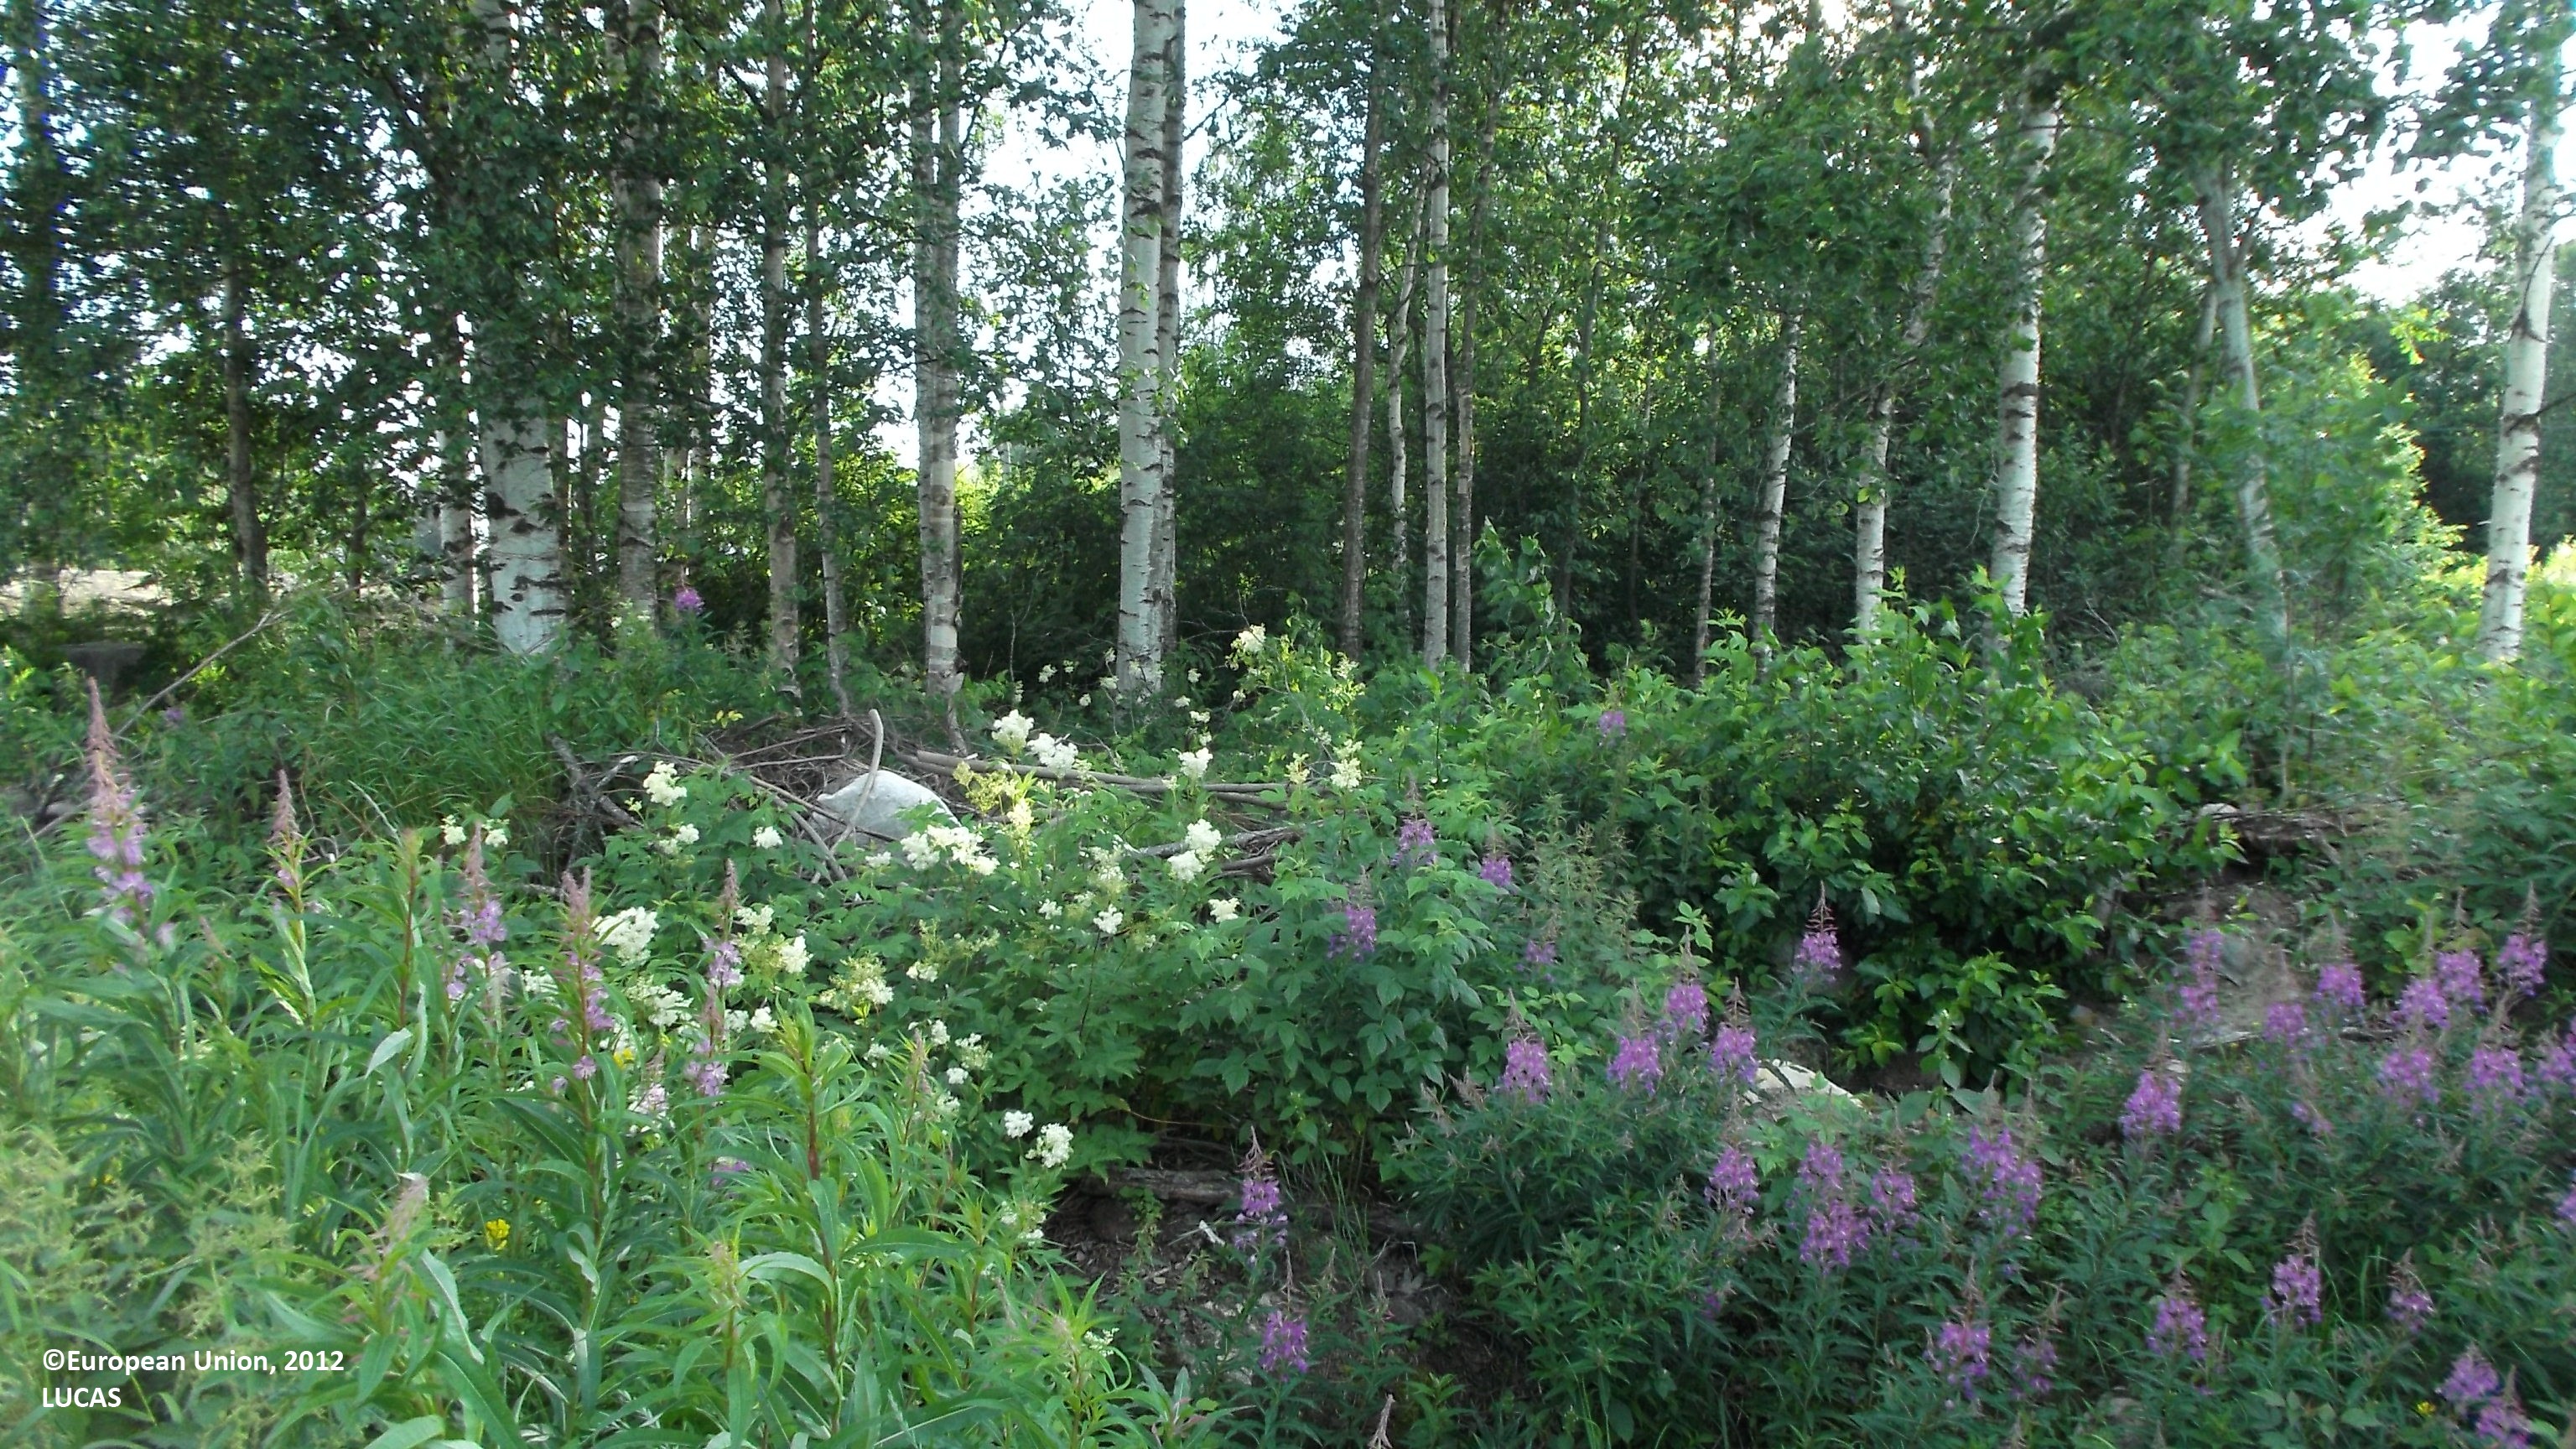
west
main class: Grassland
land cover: Grassland without tree/shrub cover
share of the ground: 50 - 75 %
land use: Fallow land
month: July
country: FI
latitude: 63.6430
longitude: 24.0199
